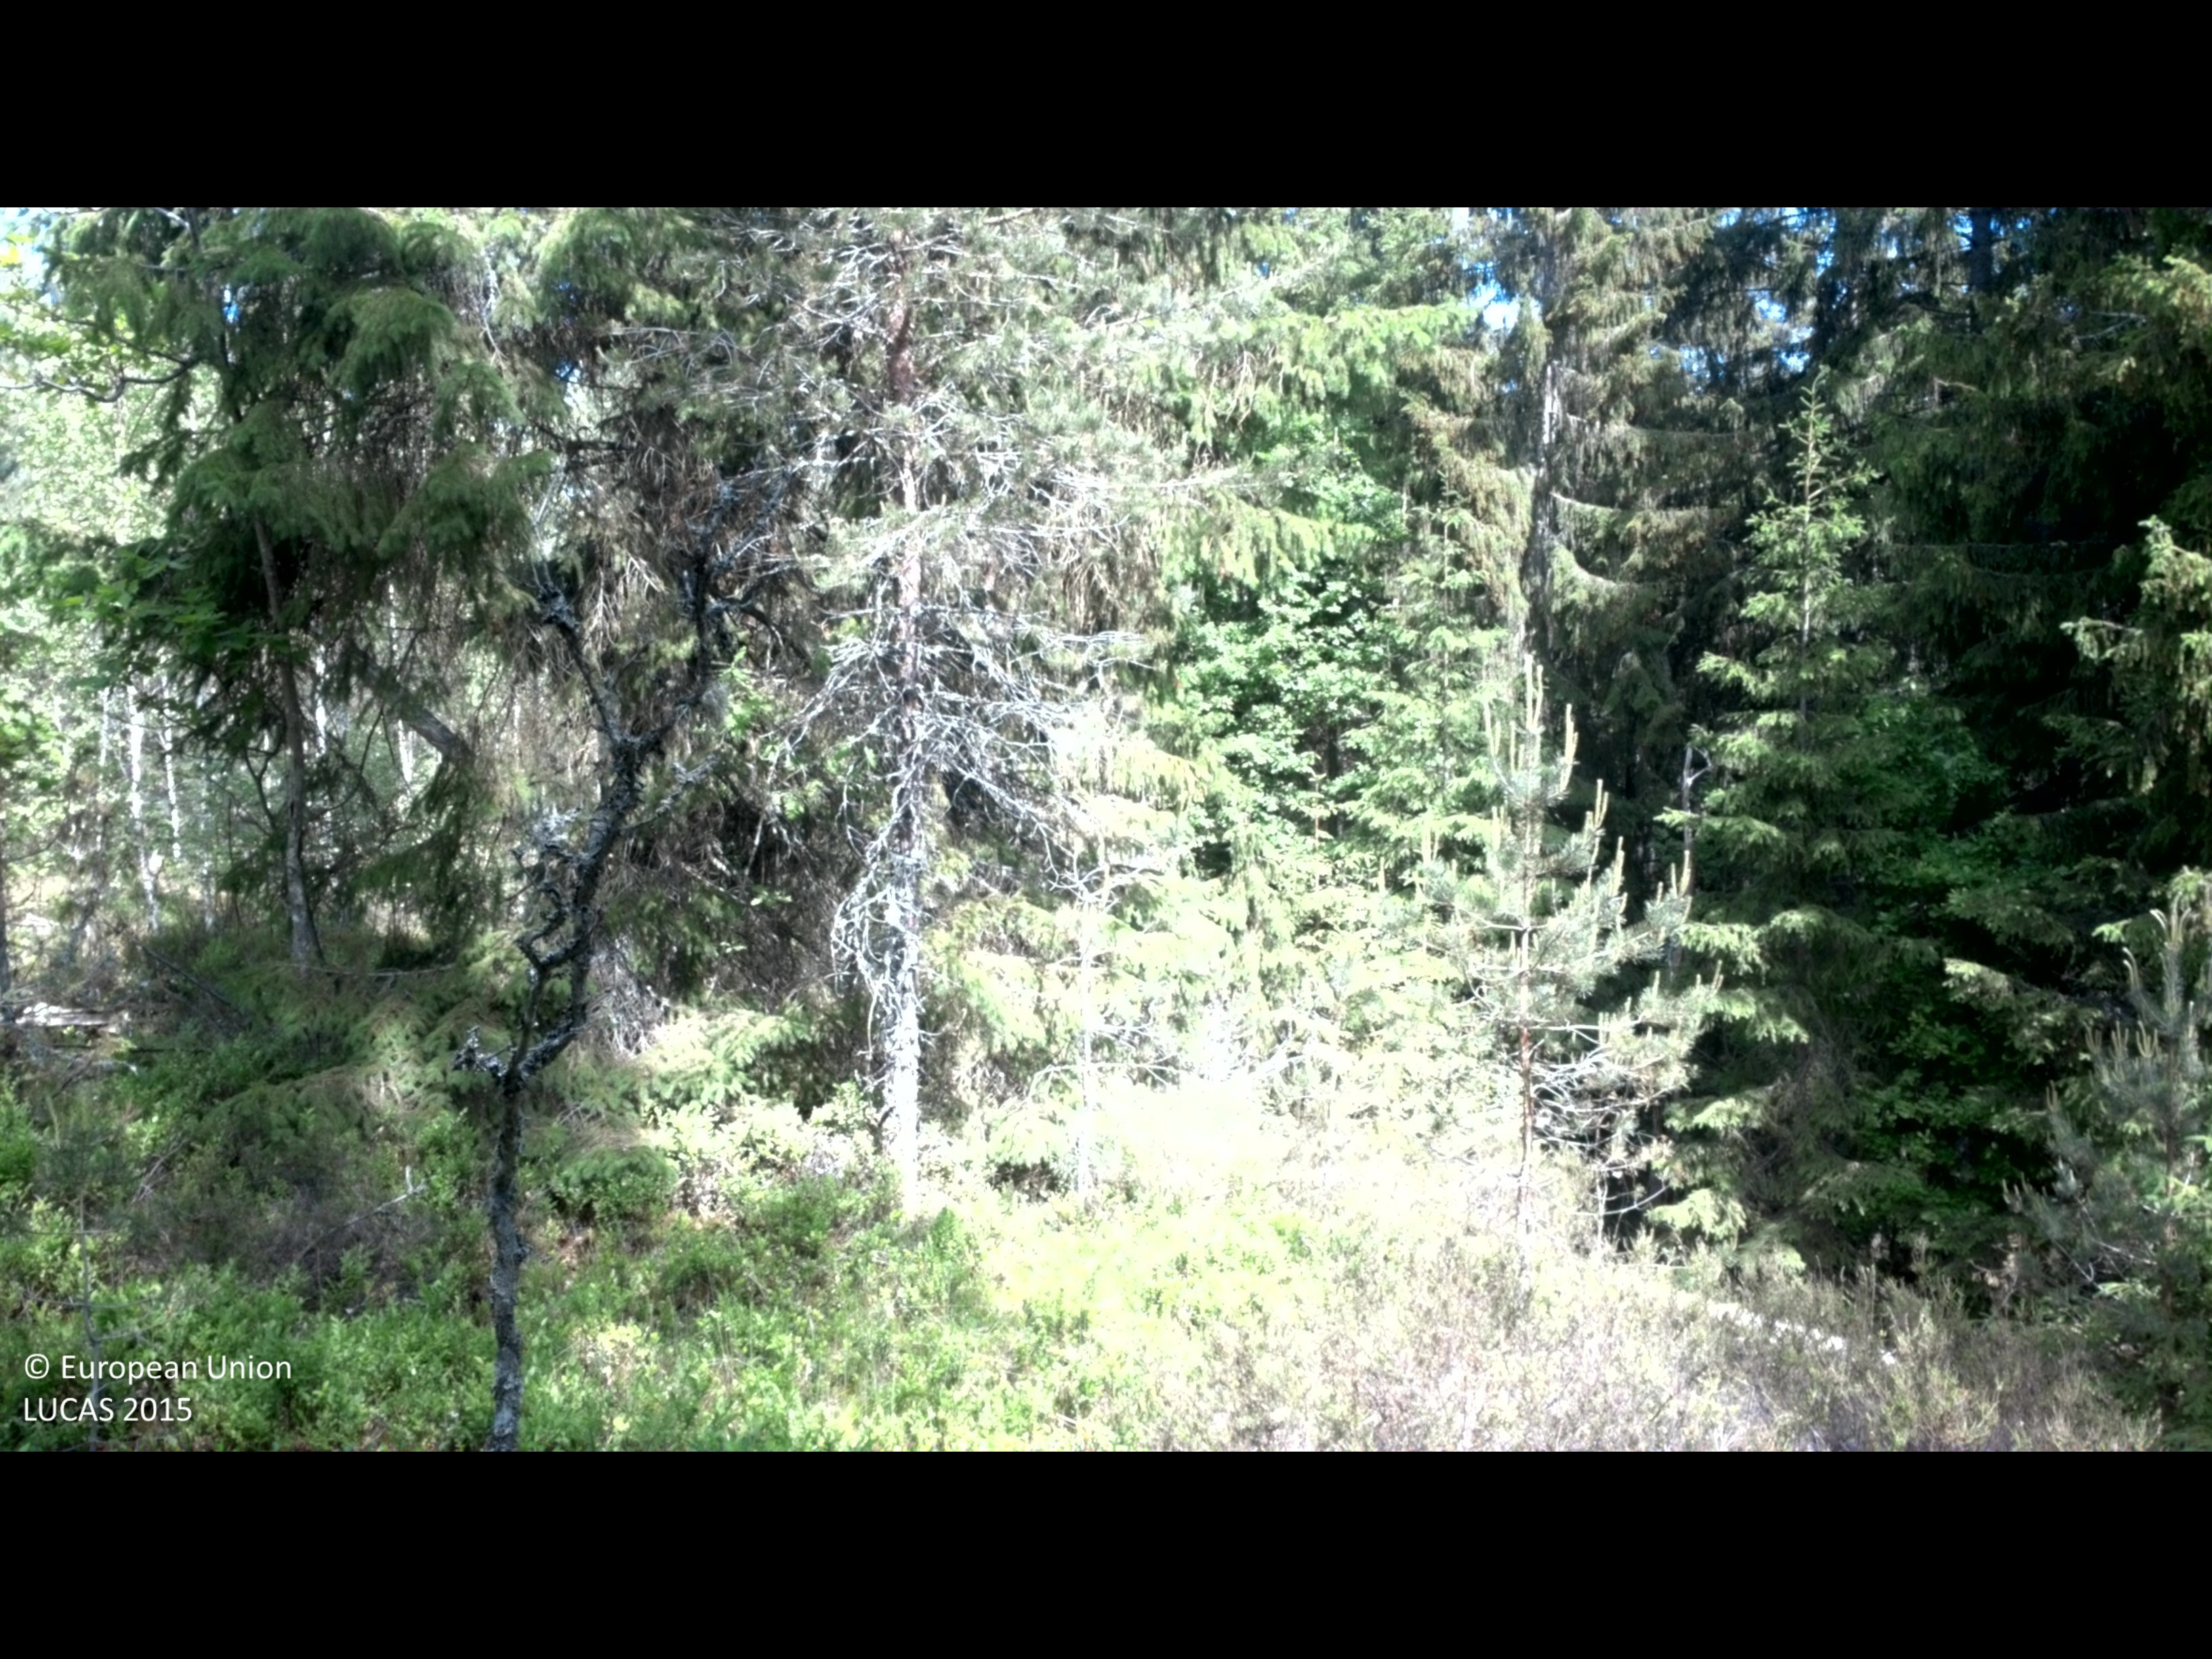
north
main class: Woodland
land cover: Spruce dominated coniferous woodland
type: boreal forest
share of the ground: 50 - 75 %
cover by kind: coniferous forest trees 45 %, shrubs 35 %, broadleaved forest trees 10 %, lichens and mosses 10 %
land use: Forestry
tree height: > 5 m
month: June
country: SE
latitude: 57.6463
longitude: 16.5162
